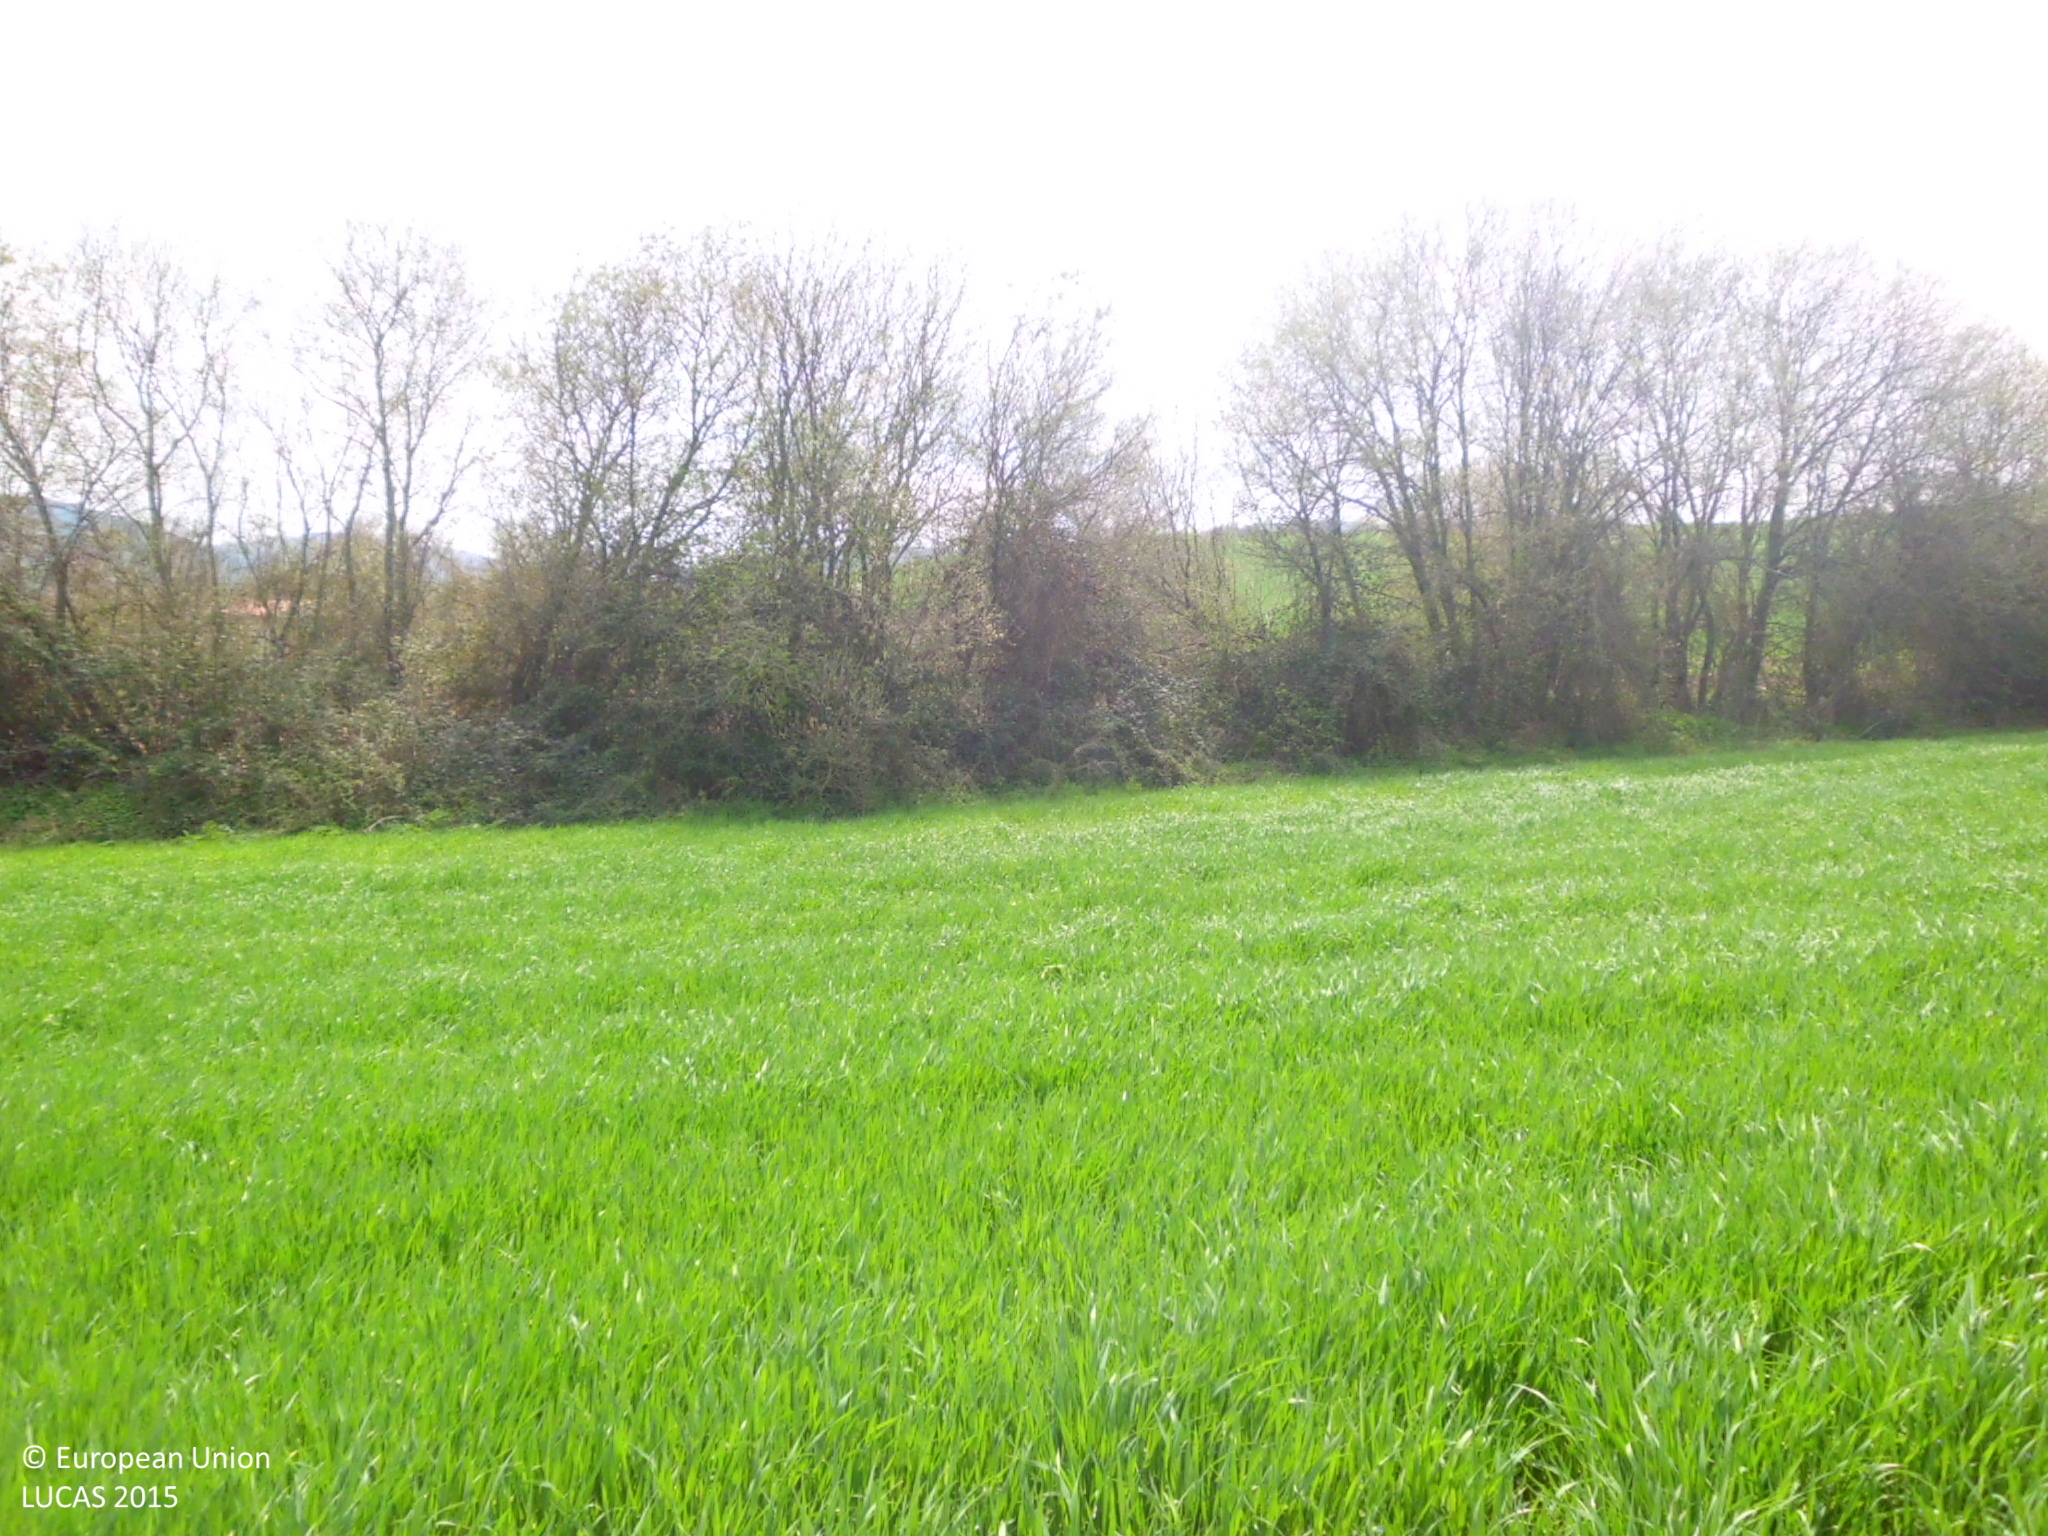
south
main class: Cropland
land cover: Barley
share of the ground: > 75 %
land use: Agriculture (excluding fallow land and kitchen gardens)
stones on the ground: < 10 %
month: April
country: ES
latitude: 42.3929
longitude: -3.3086
